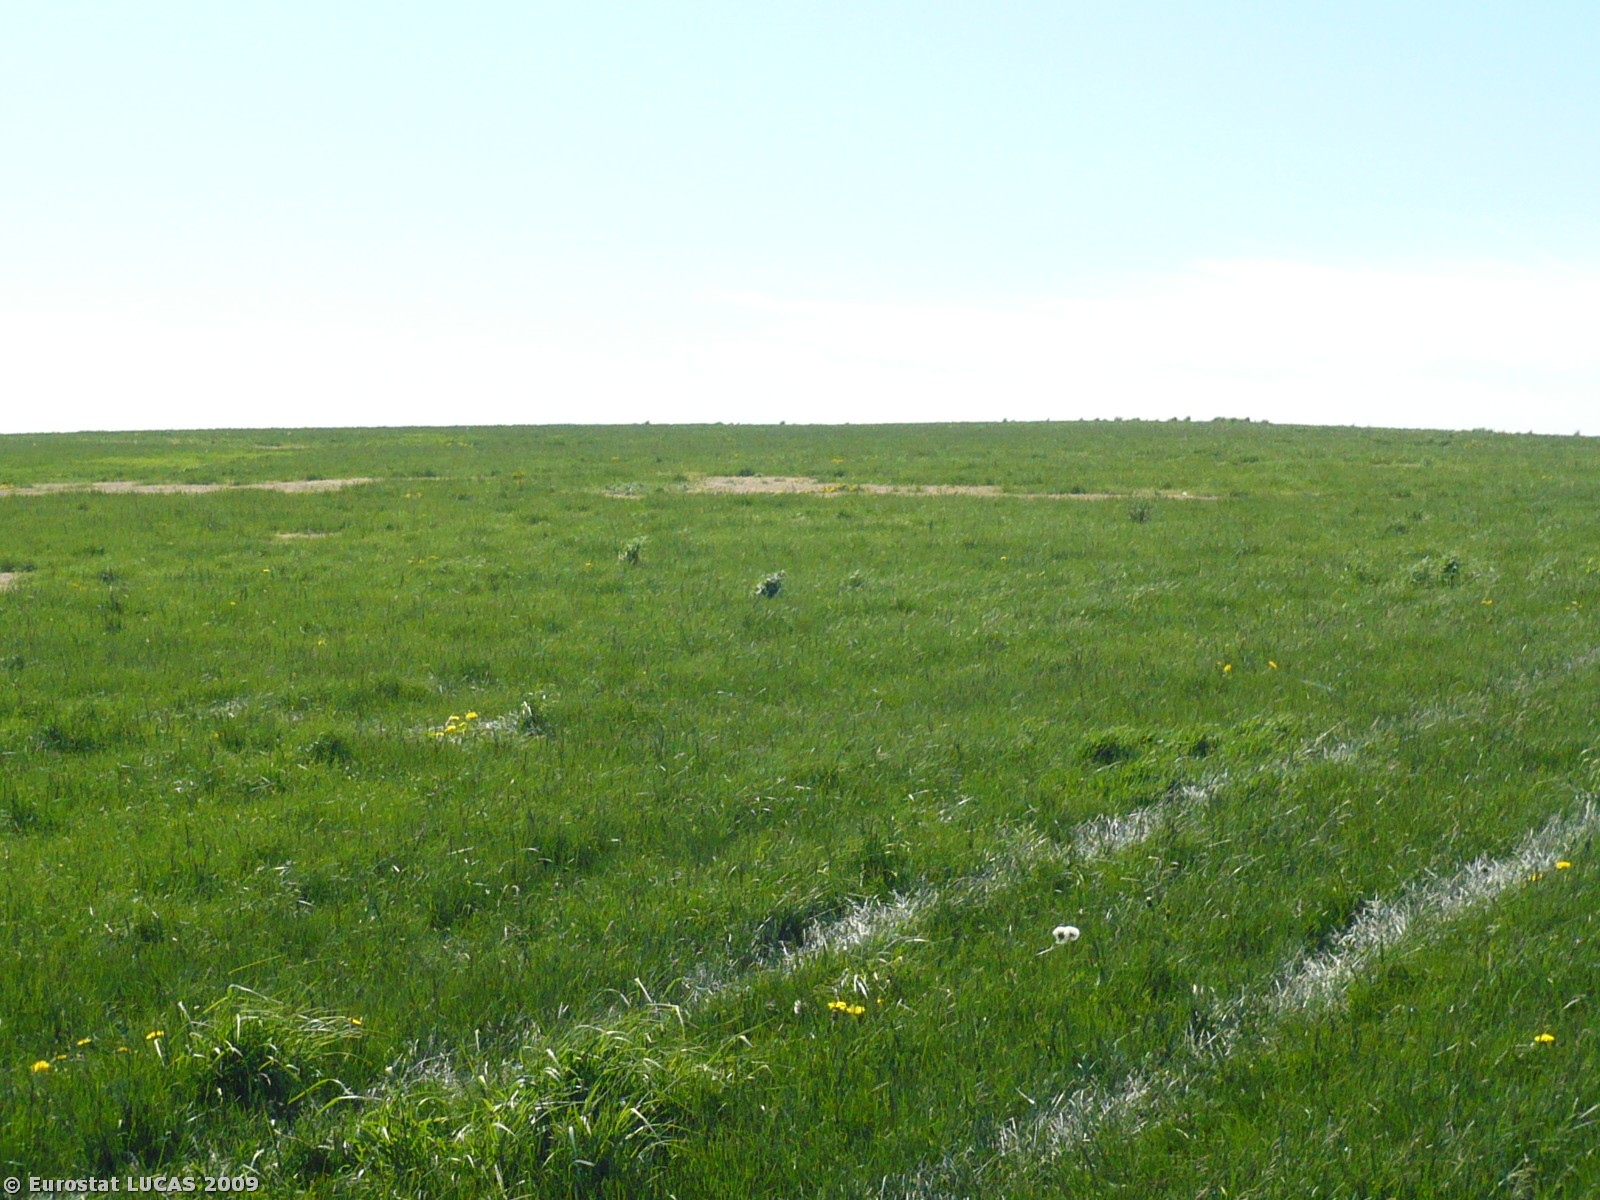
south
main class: Grassland
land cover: Grassland without tree/shrub cover
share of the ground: > 75 %
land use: Agriculture (excluding fallow land and kitchen gardens)
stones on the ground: < 10 %
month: May
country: DK
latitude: 55.1654
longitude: 11.9922
